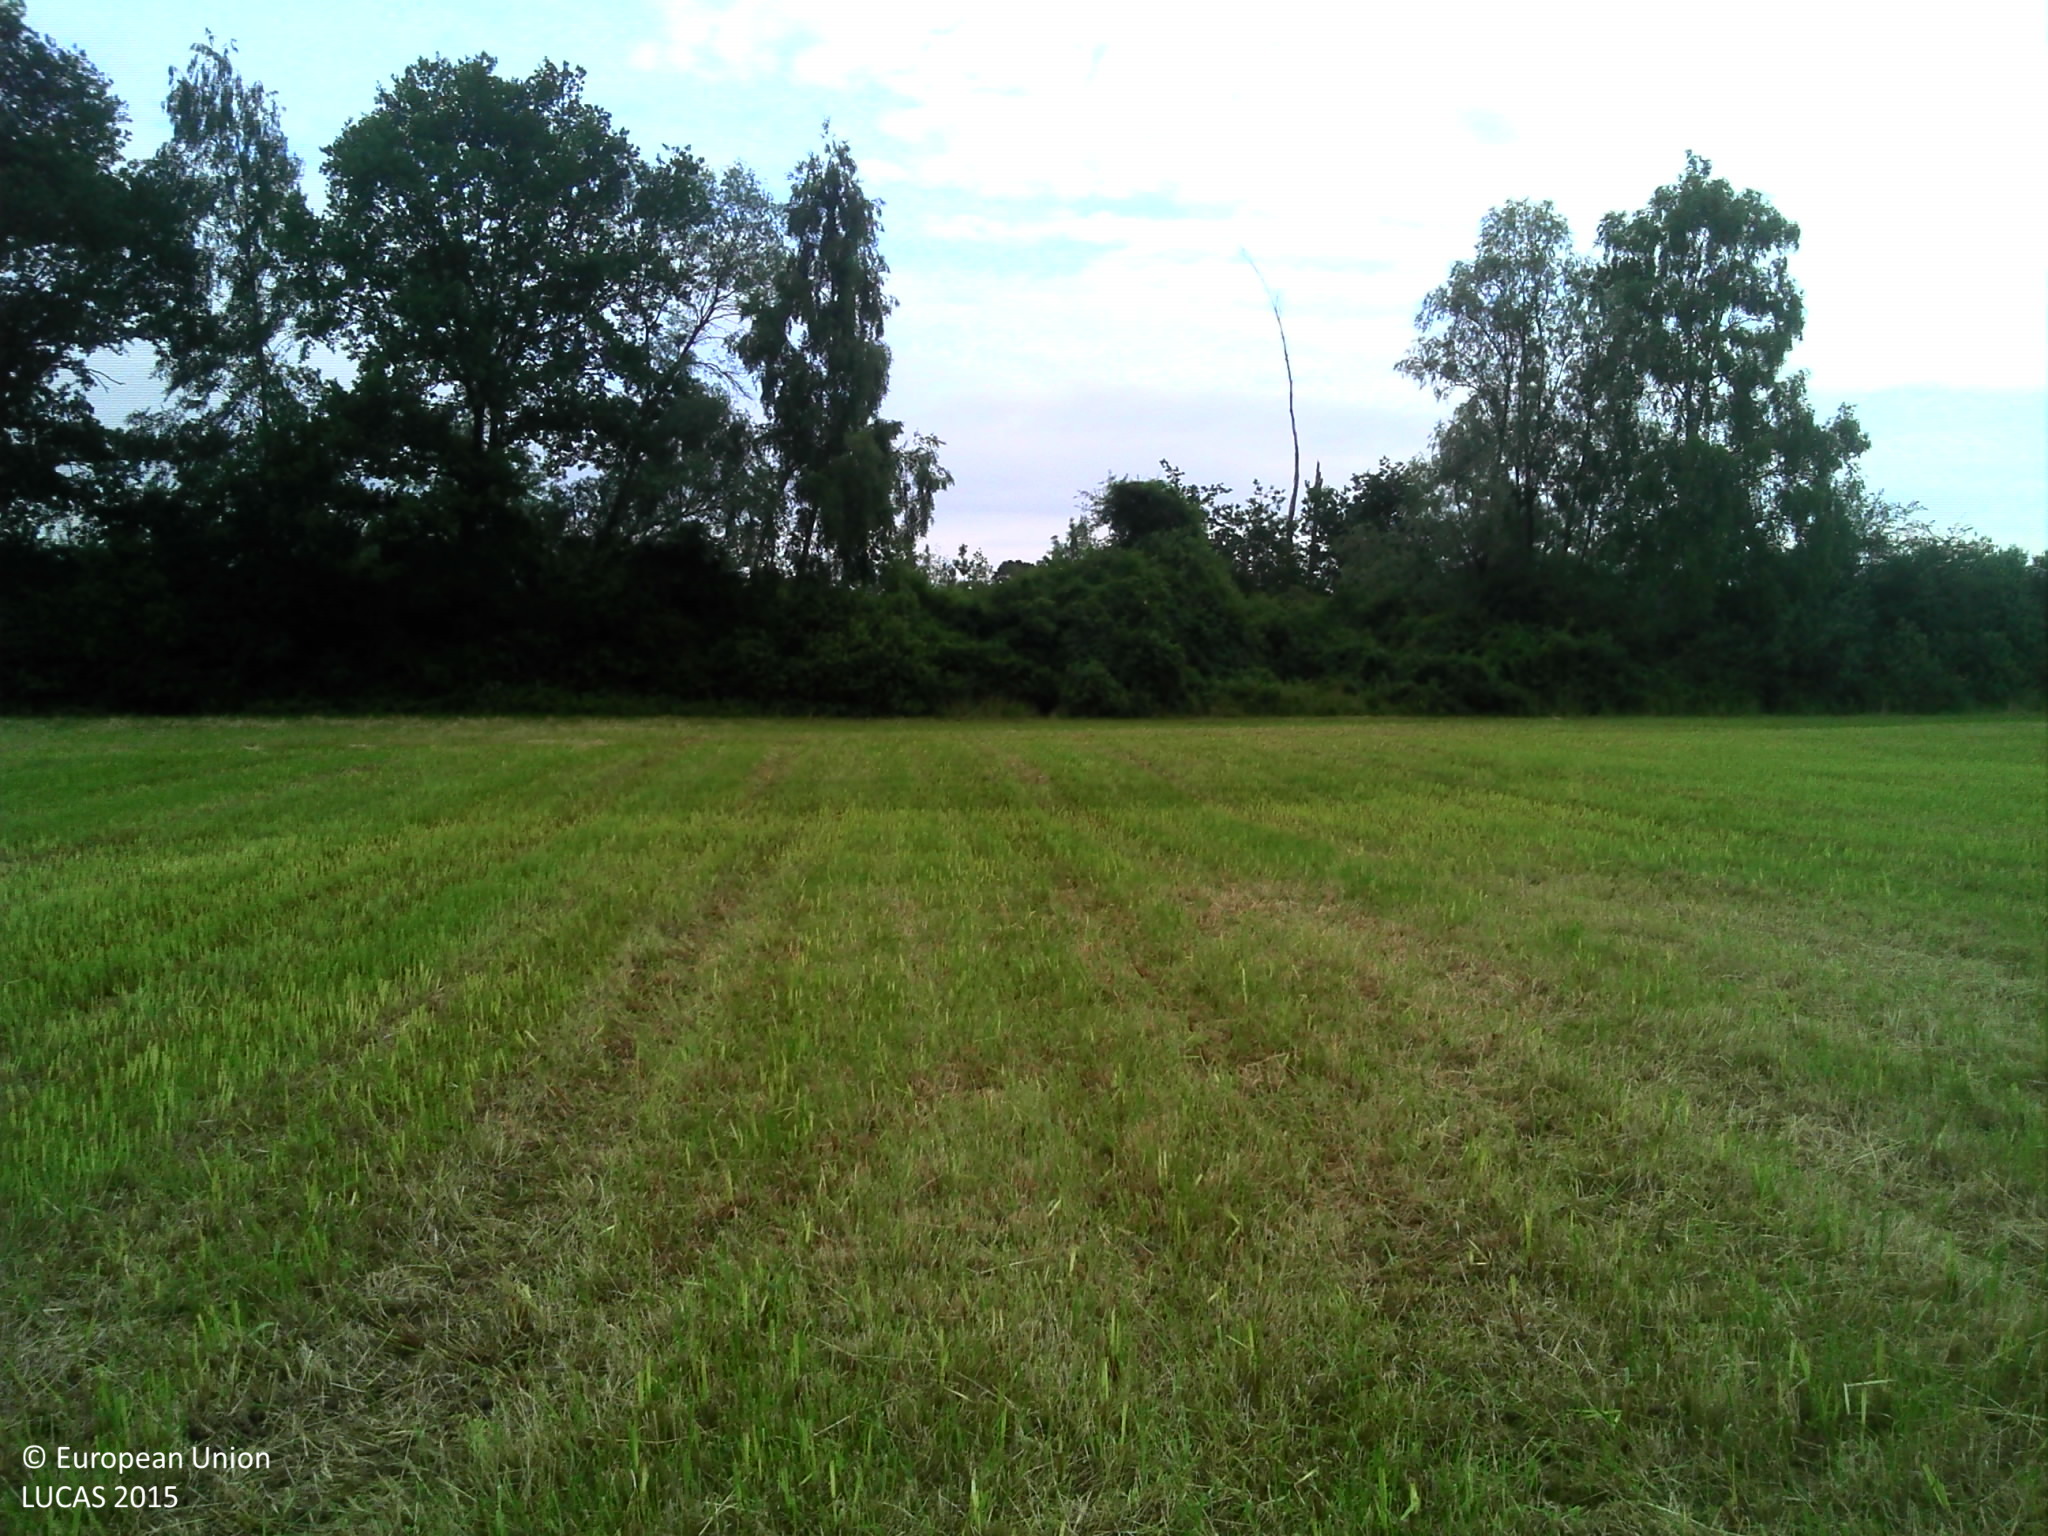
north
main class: Grassland
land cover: Grassland without tree/shrub cover
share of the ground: > 75 %
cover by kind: herbaceous plants 100 %
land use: Agriculture (excluding fallow land and kitchen gardens)
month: June
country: FR
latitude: 48.4856
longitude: 7.6061
